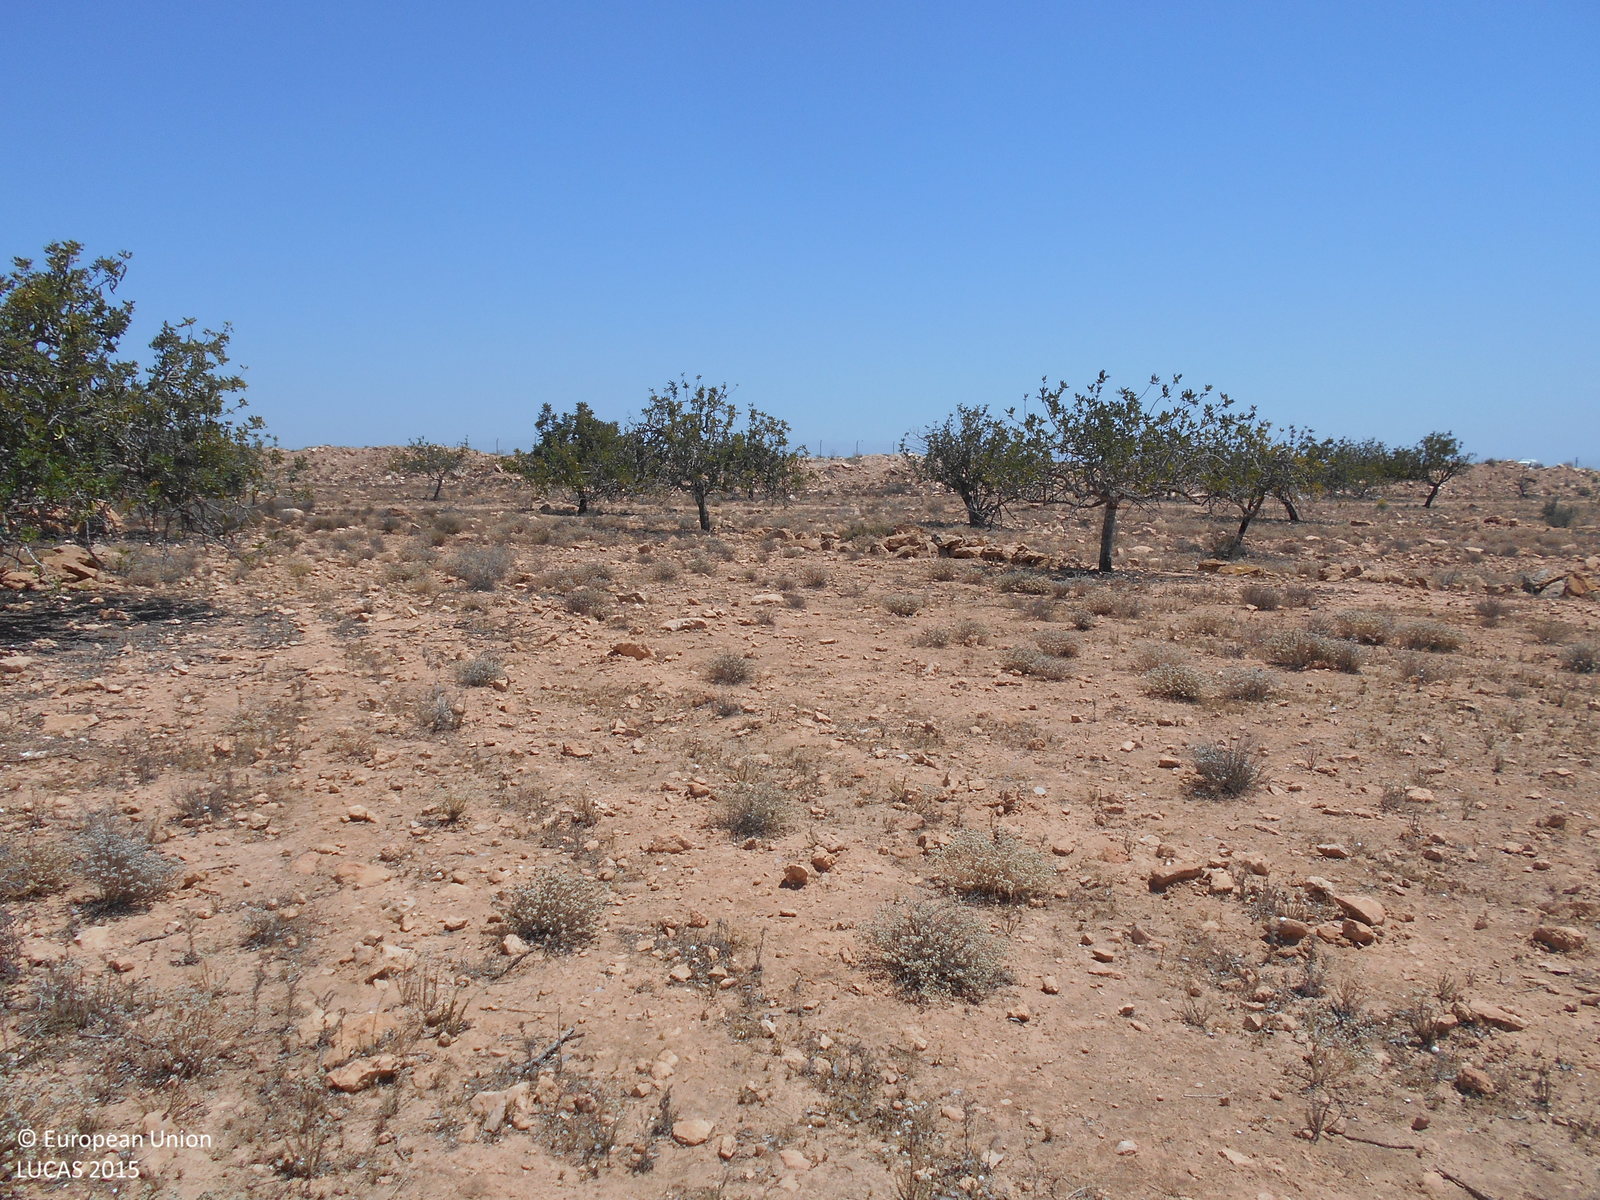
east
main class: Cropland
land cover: Nuts trees
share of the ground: 10 - 25 %
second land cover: Grassland without tree/shrub cover
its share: 10 - 25 %
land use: Agriculture (excluding fallow land and kitchen gardens)
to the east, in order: Nuts trees; Grassland without tree/shrub cover; Tracks; Nuts trees; Shrubland without tree cover; Other bare soil; Rock outcrops; Fences; Shrubland without tree cover; Shrubland with sparse tree cover
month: June
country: ES
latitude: 37.8628
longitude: -0.9505
